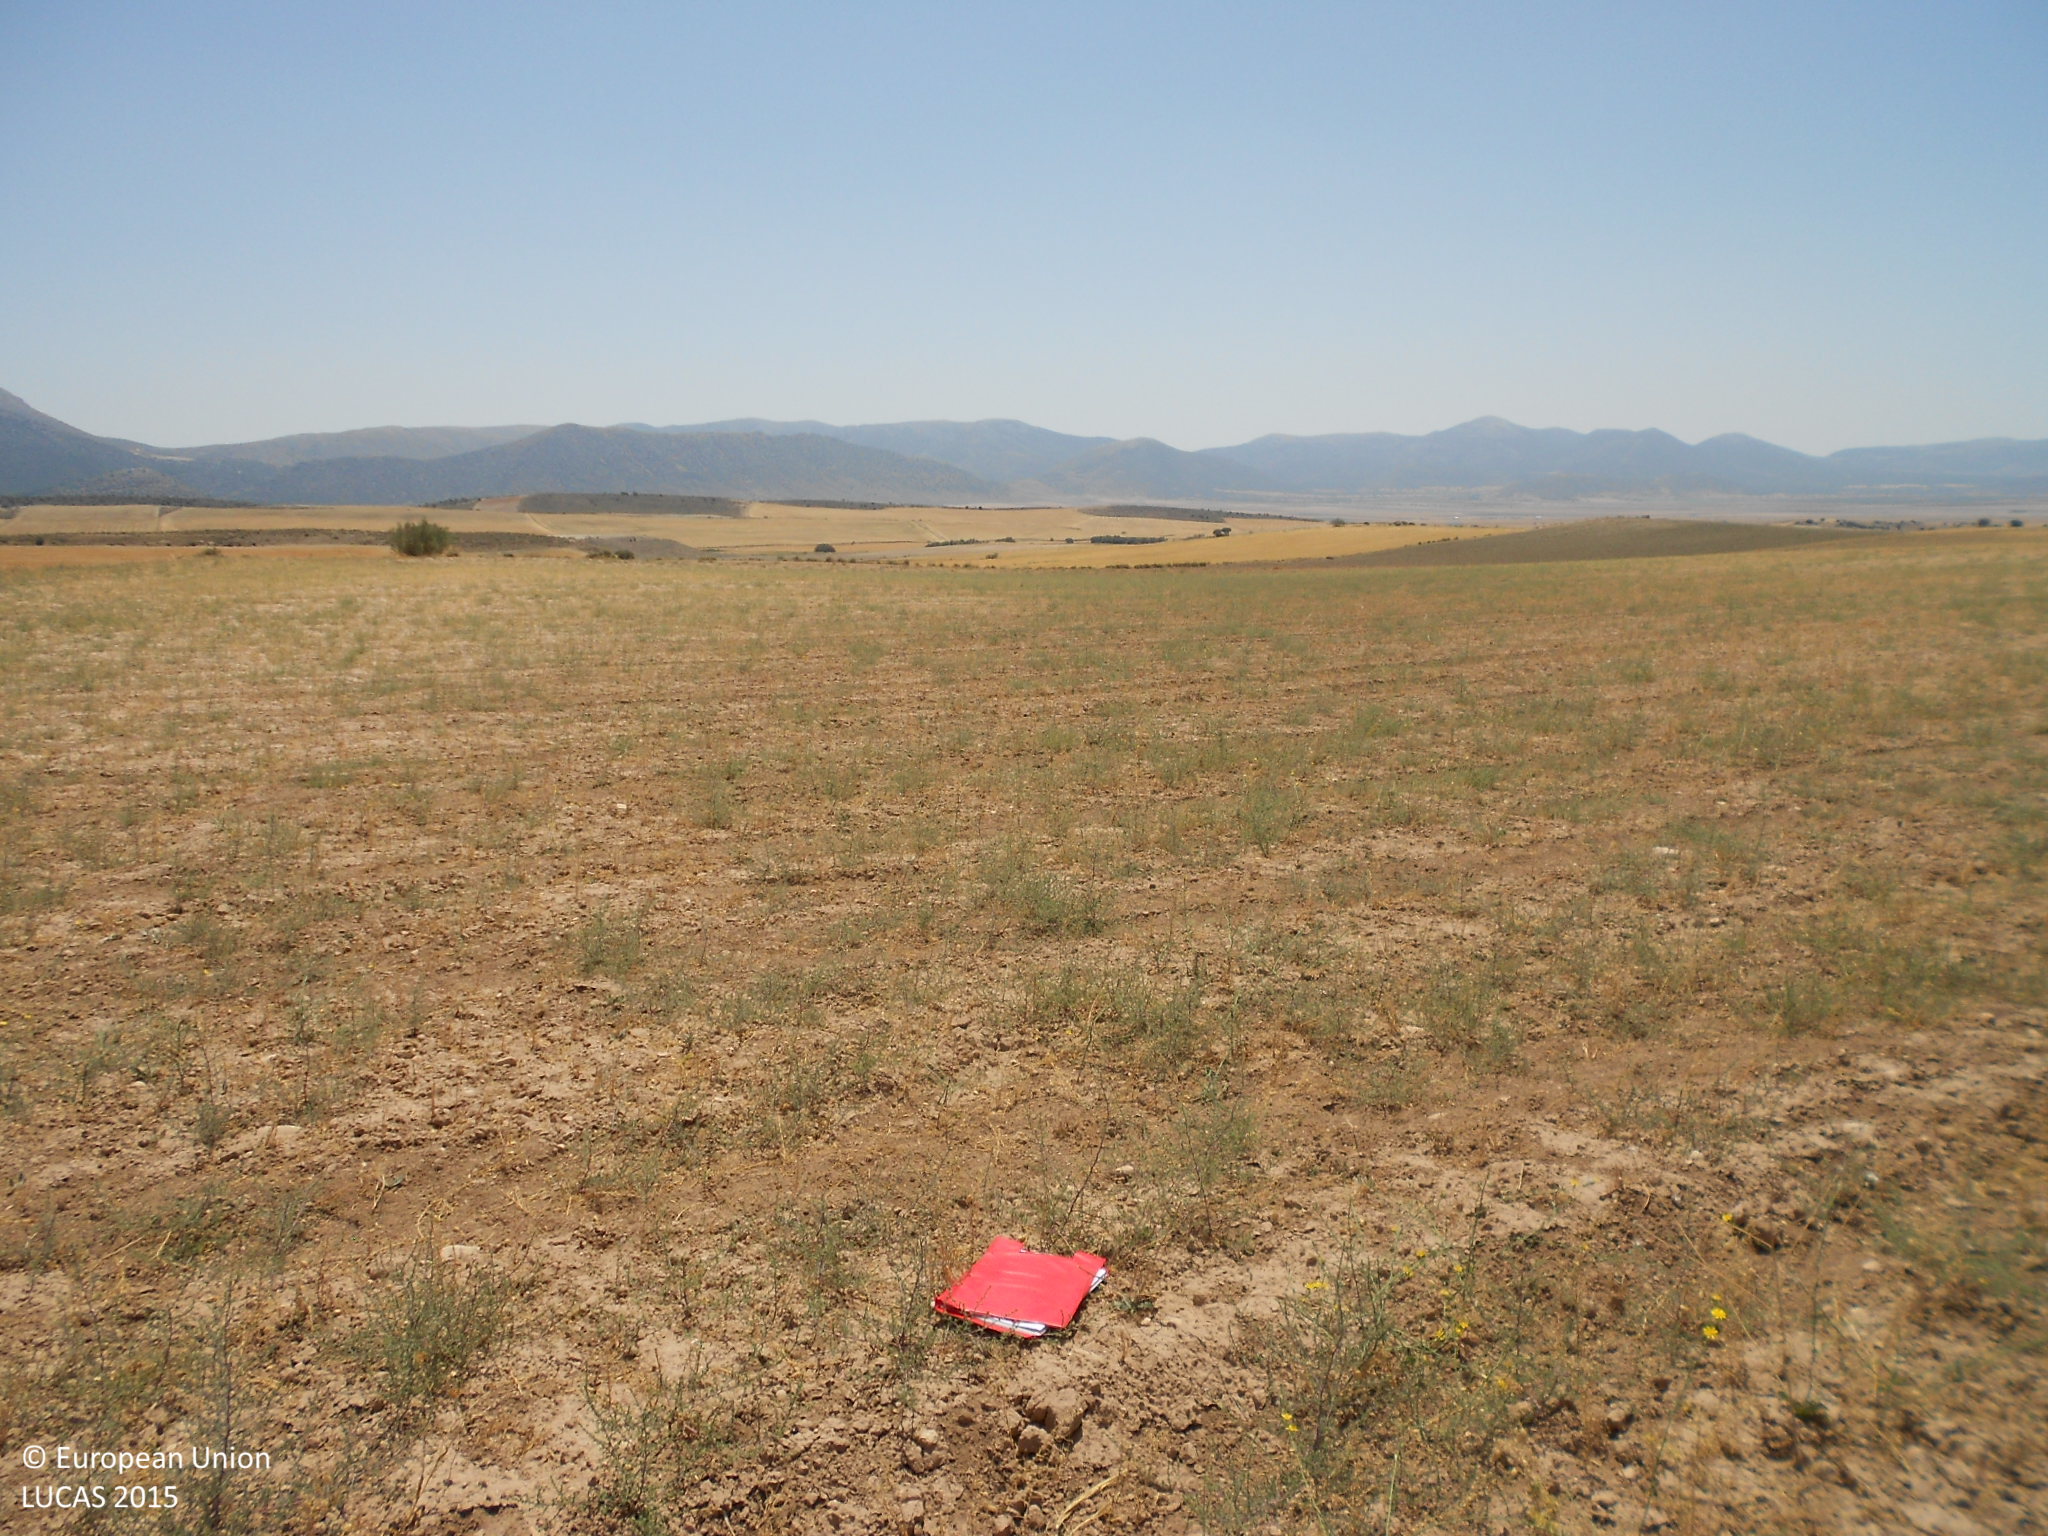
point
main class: Grassland
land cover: Spontaneously vegetated surfaces
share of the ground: 25 - 50 %
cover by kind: consolidated bare surface 60 %, herbaceous plants 40 %
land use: Fallow land
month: August
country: ES
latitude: 37.7366
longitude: -2.2763
